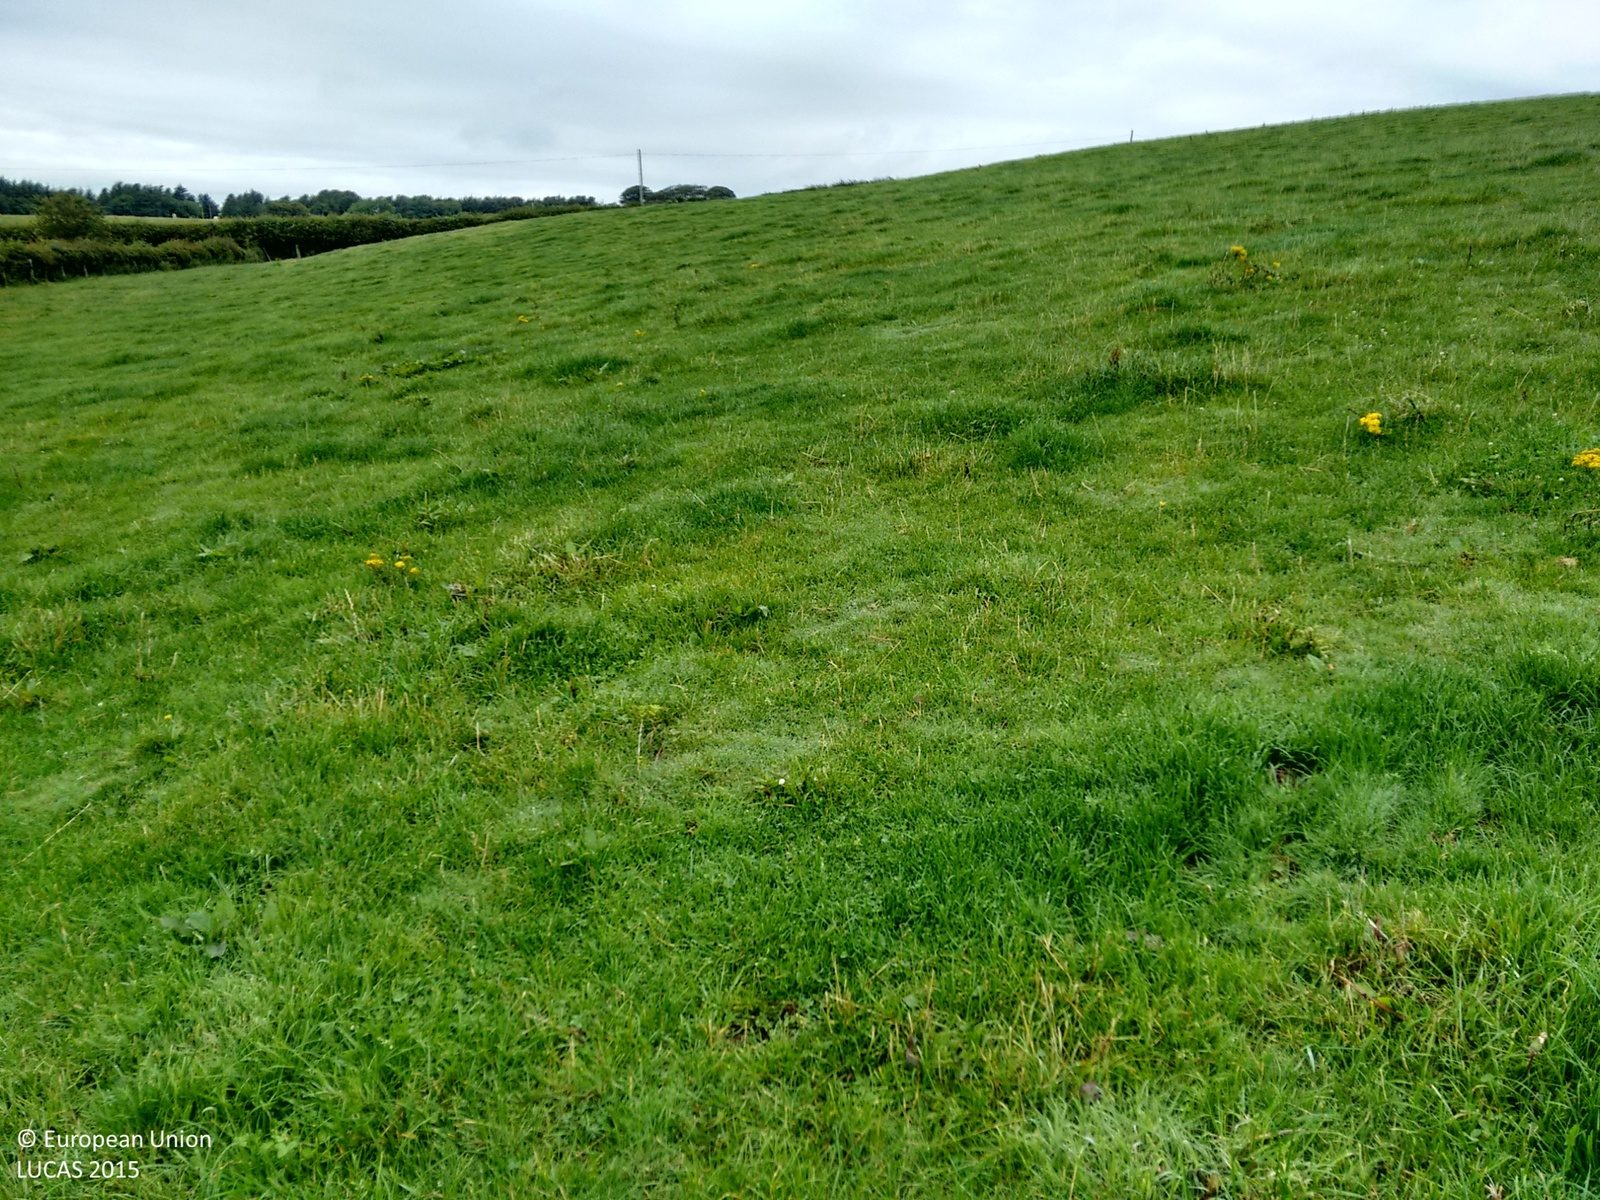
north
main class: Grassland
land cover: Grassland without tree/shrub cover
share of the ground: > 75 %
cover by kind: herbaceous plants 100 %
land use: Agriculture (excluding fallow land and kitchen gardens)
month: August
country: GB
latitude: 54.8813
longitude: -4.9674
